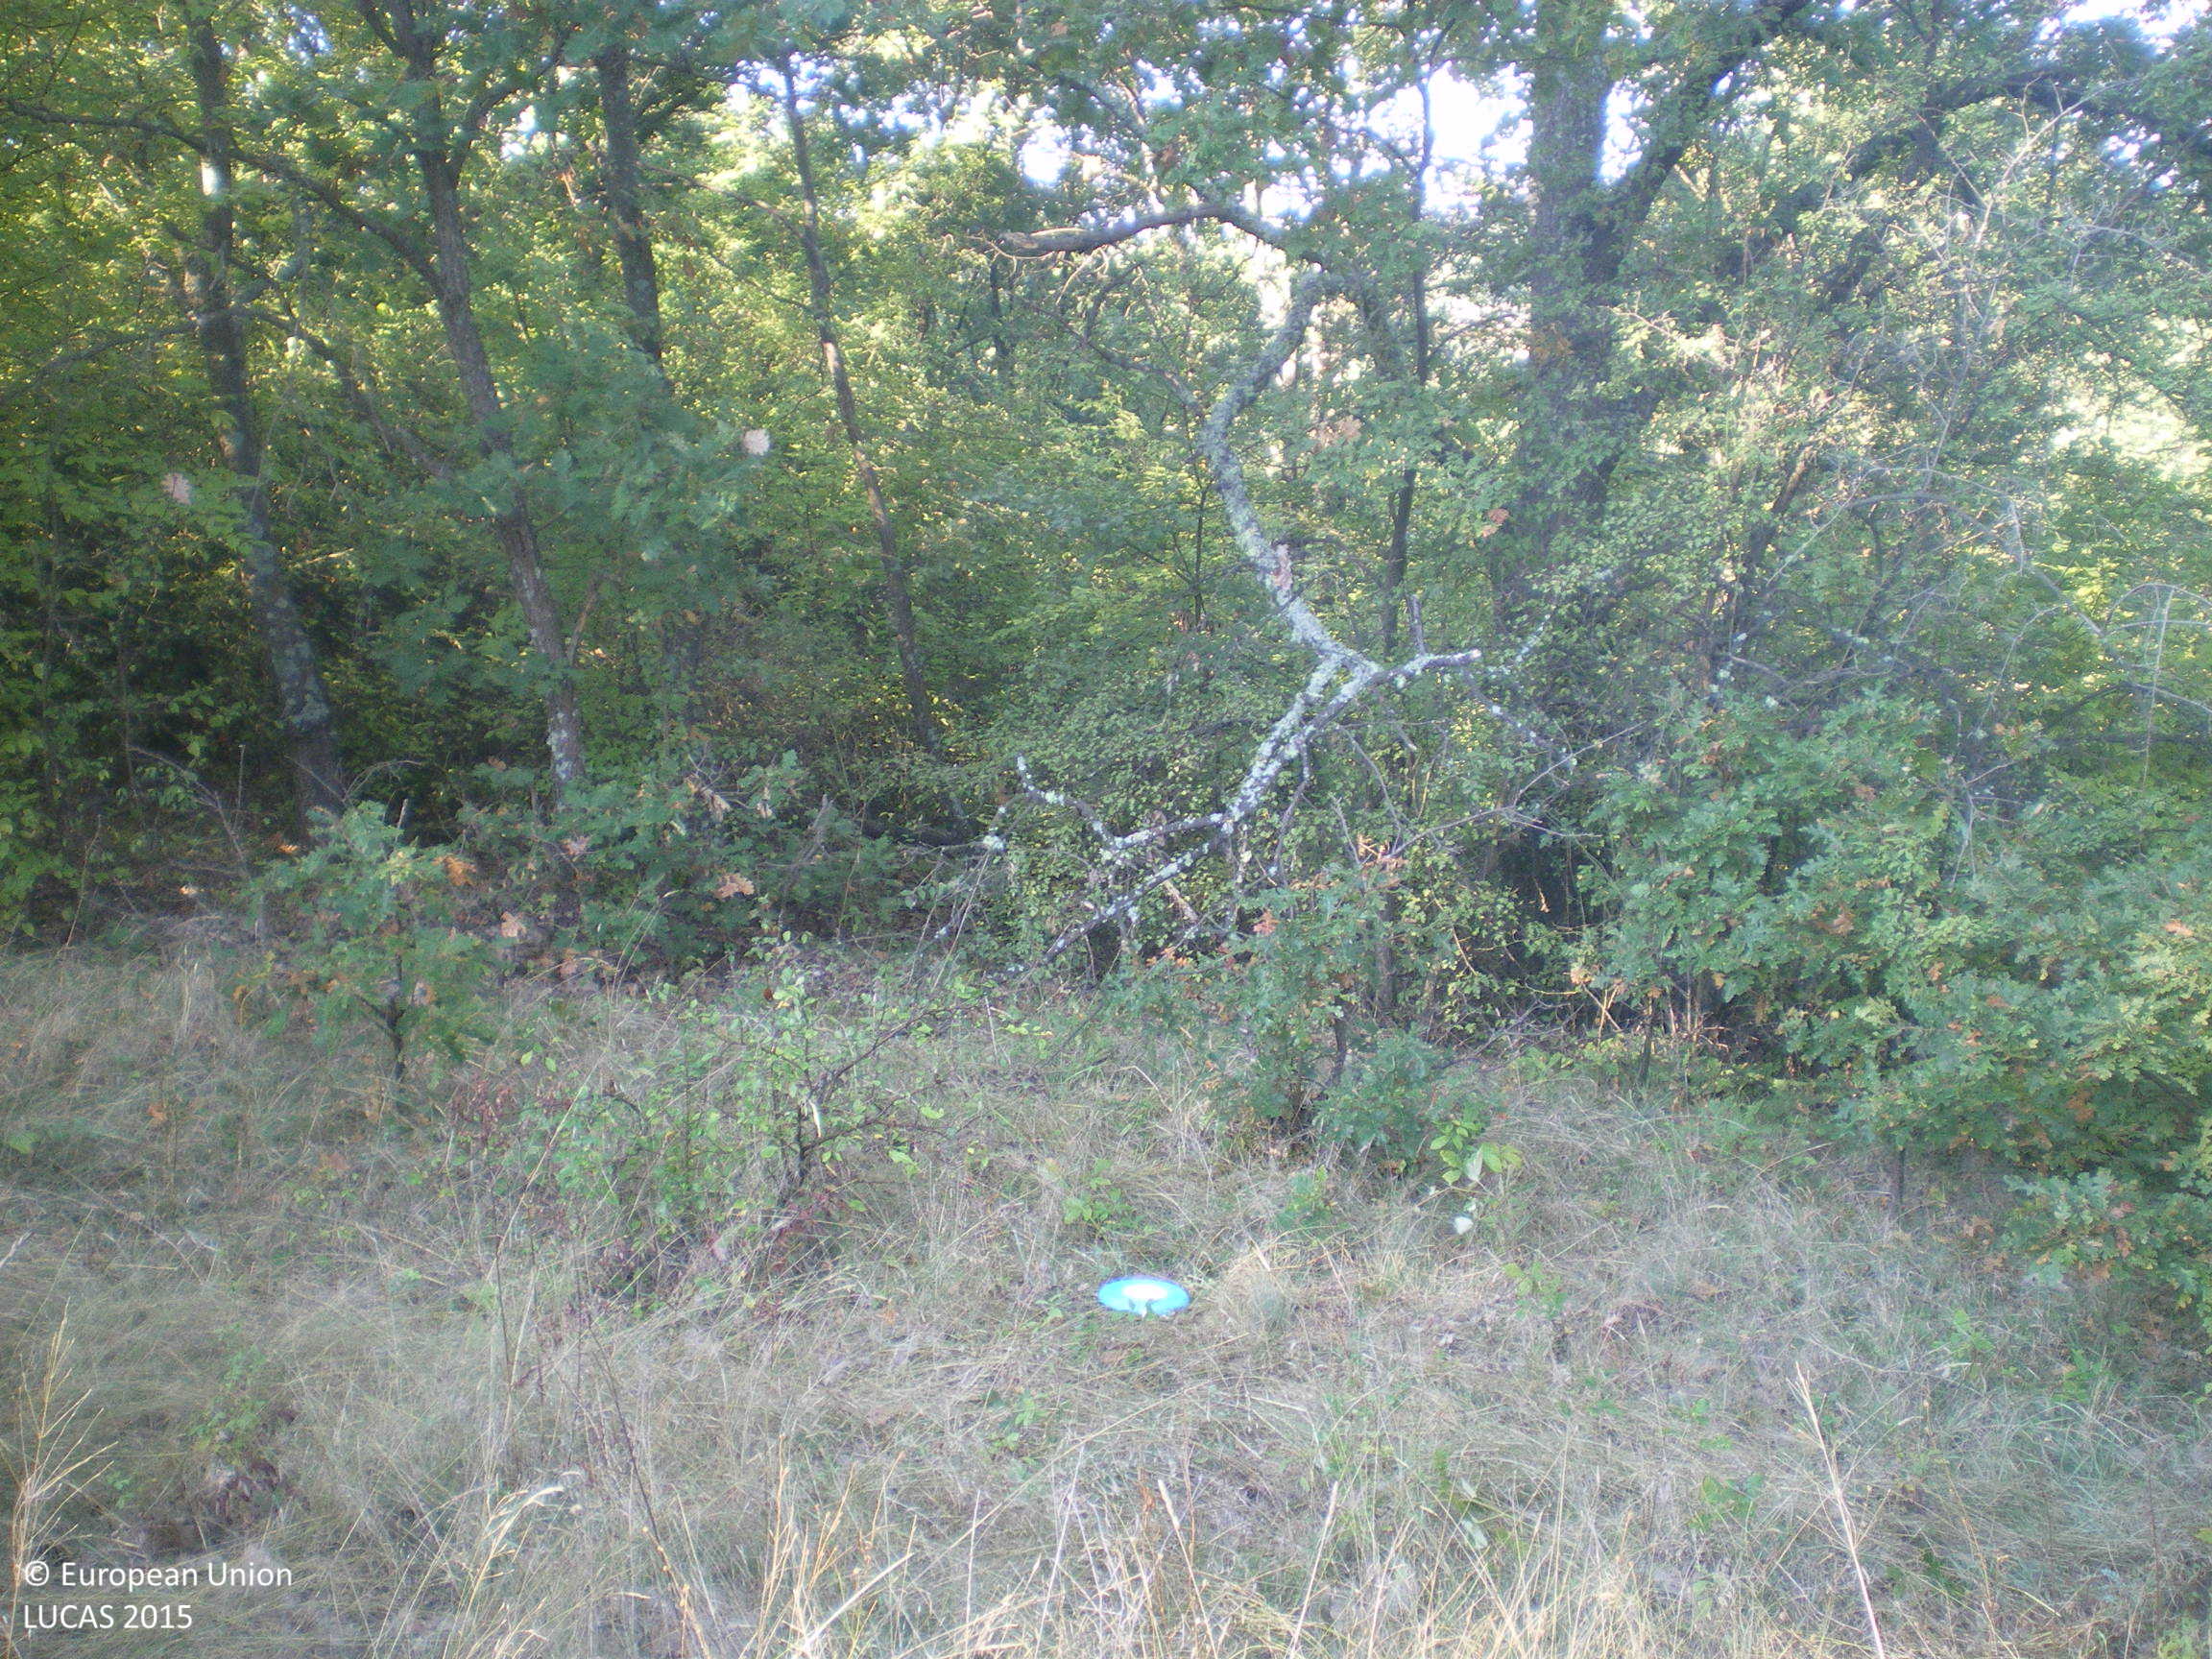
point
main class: Woodland
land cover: Broadleaved woodland
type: mesophytic deciduous forest
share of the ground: > 75 %
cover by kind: broadleaved forest trees 100 %
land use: Forestry
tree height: > 5 m
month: October
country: BG
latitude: 42.0335
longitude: 26.2297
